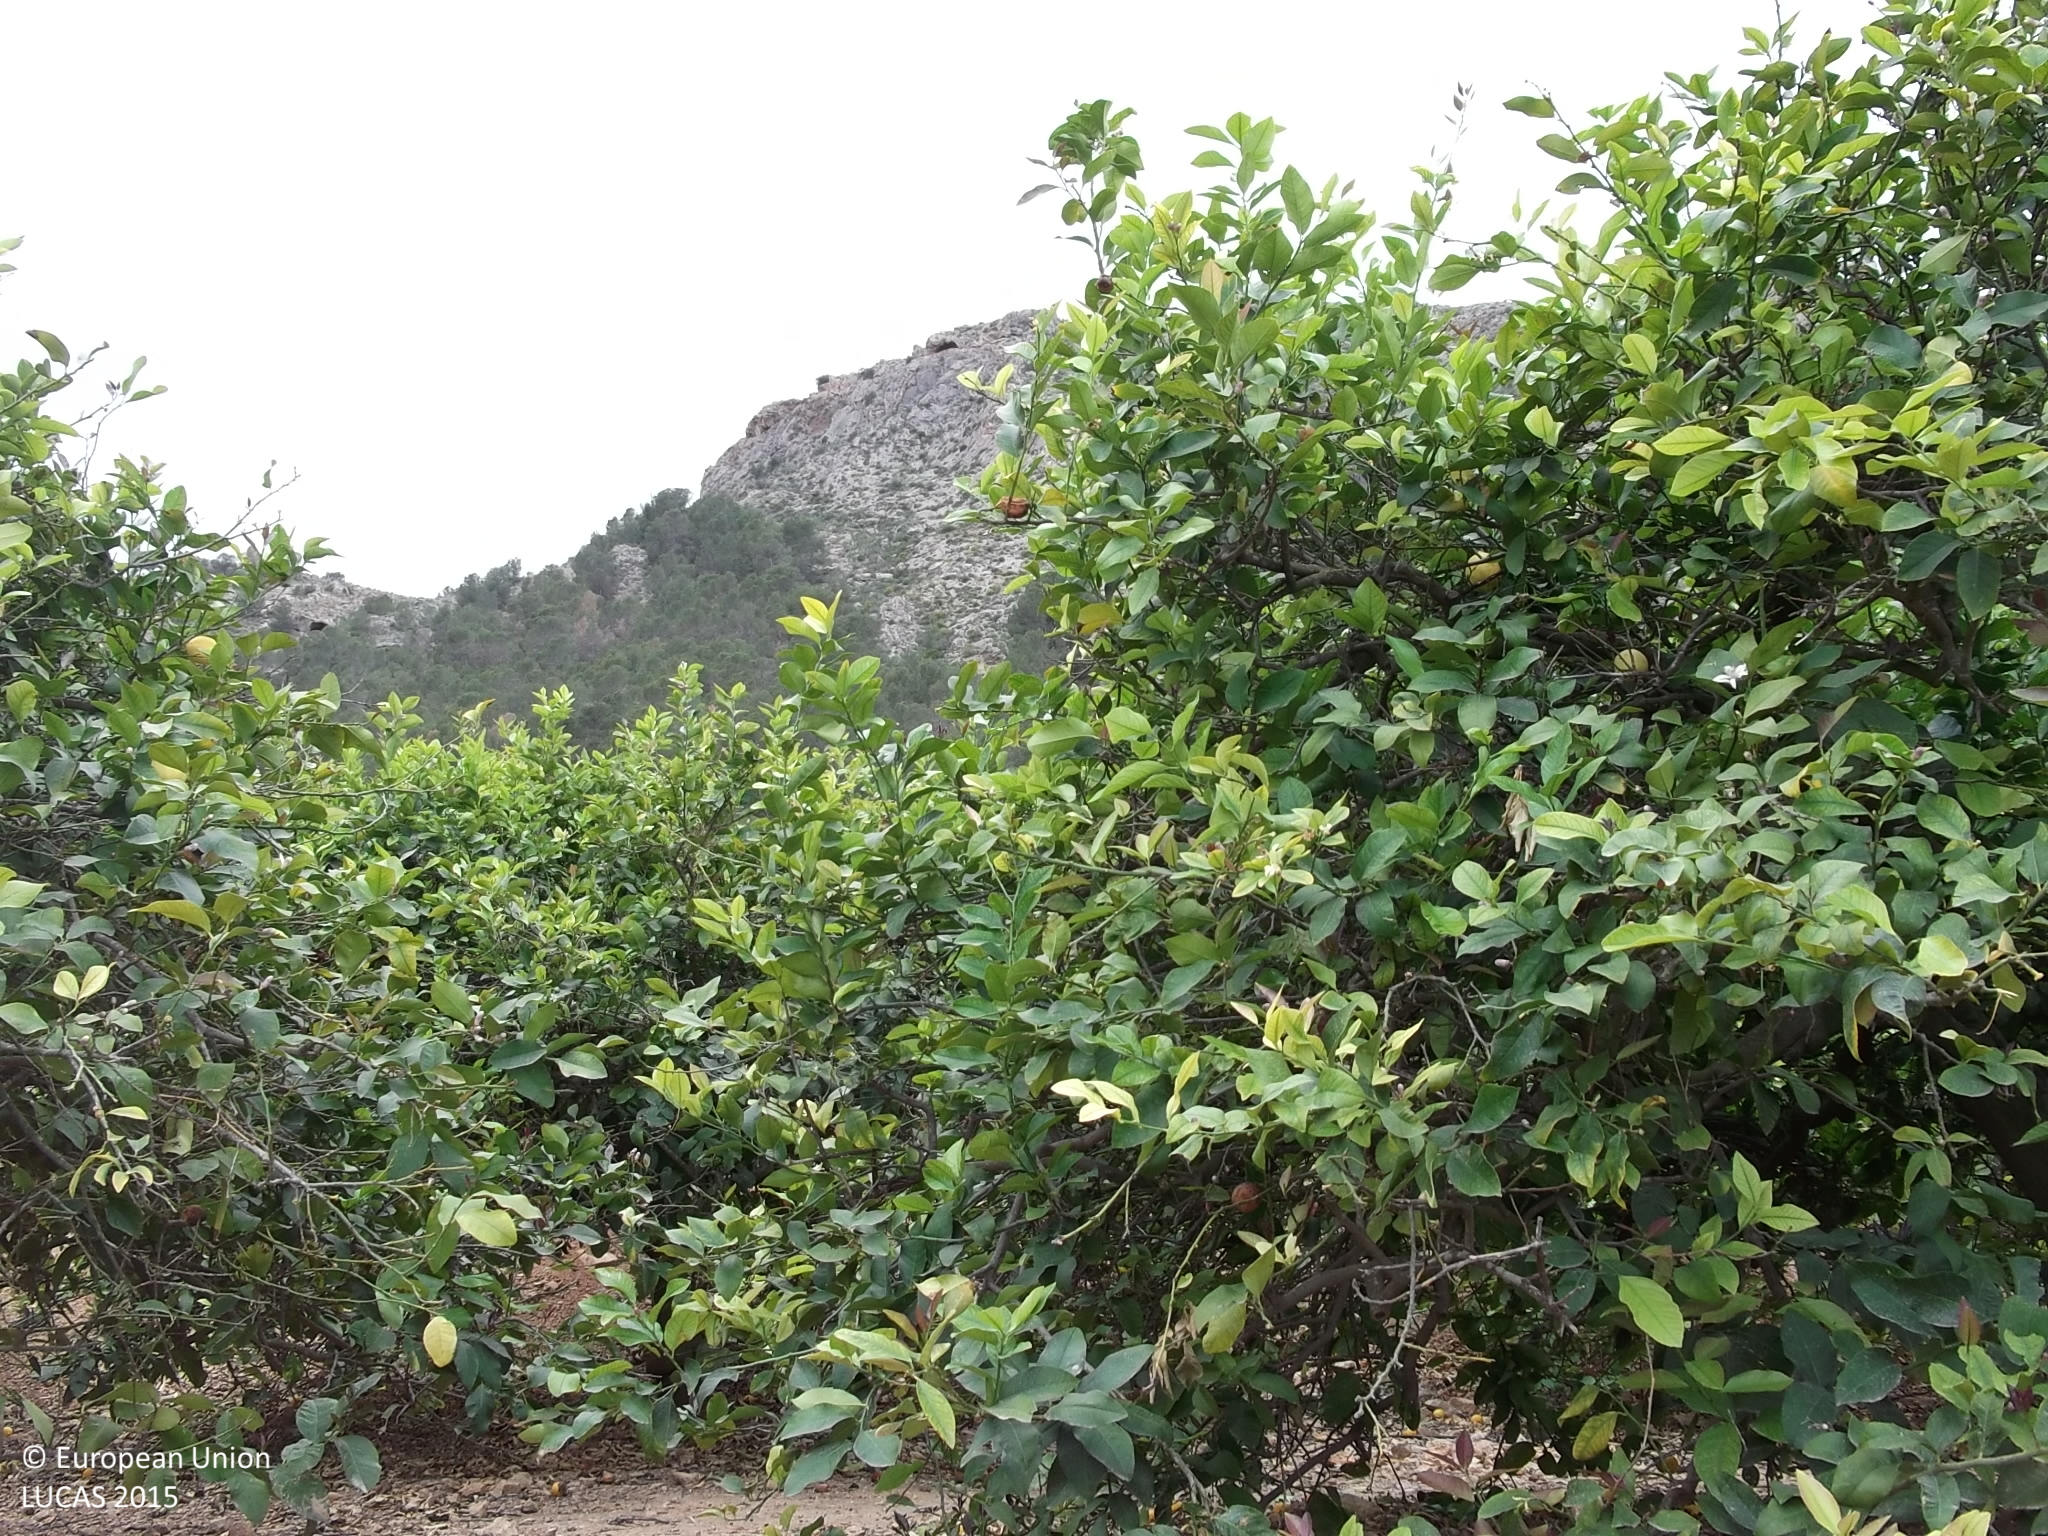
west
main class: Cropland
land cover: Other citrus fruit
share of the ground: 50 - 75 %
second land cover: Other bare soil
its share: > 75 %
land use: Agriculture (excluding fallow land and kitchen gardens)
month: April
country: ES
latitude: 38.1140
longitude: -0.9912
